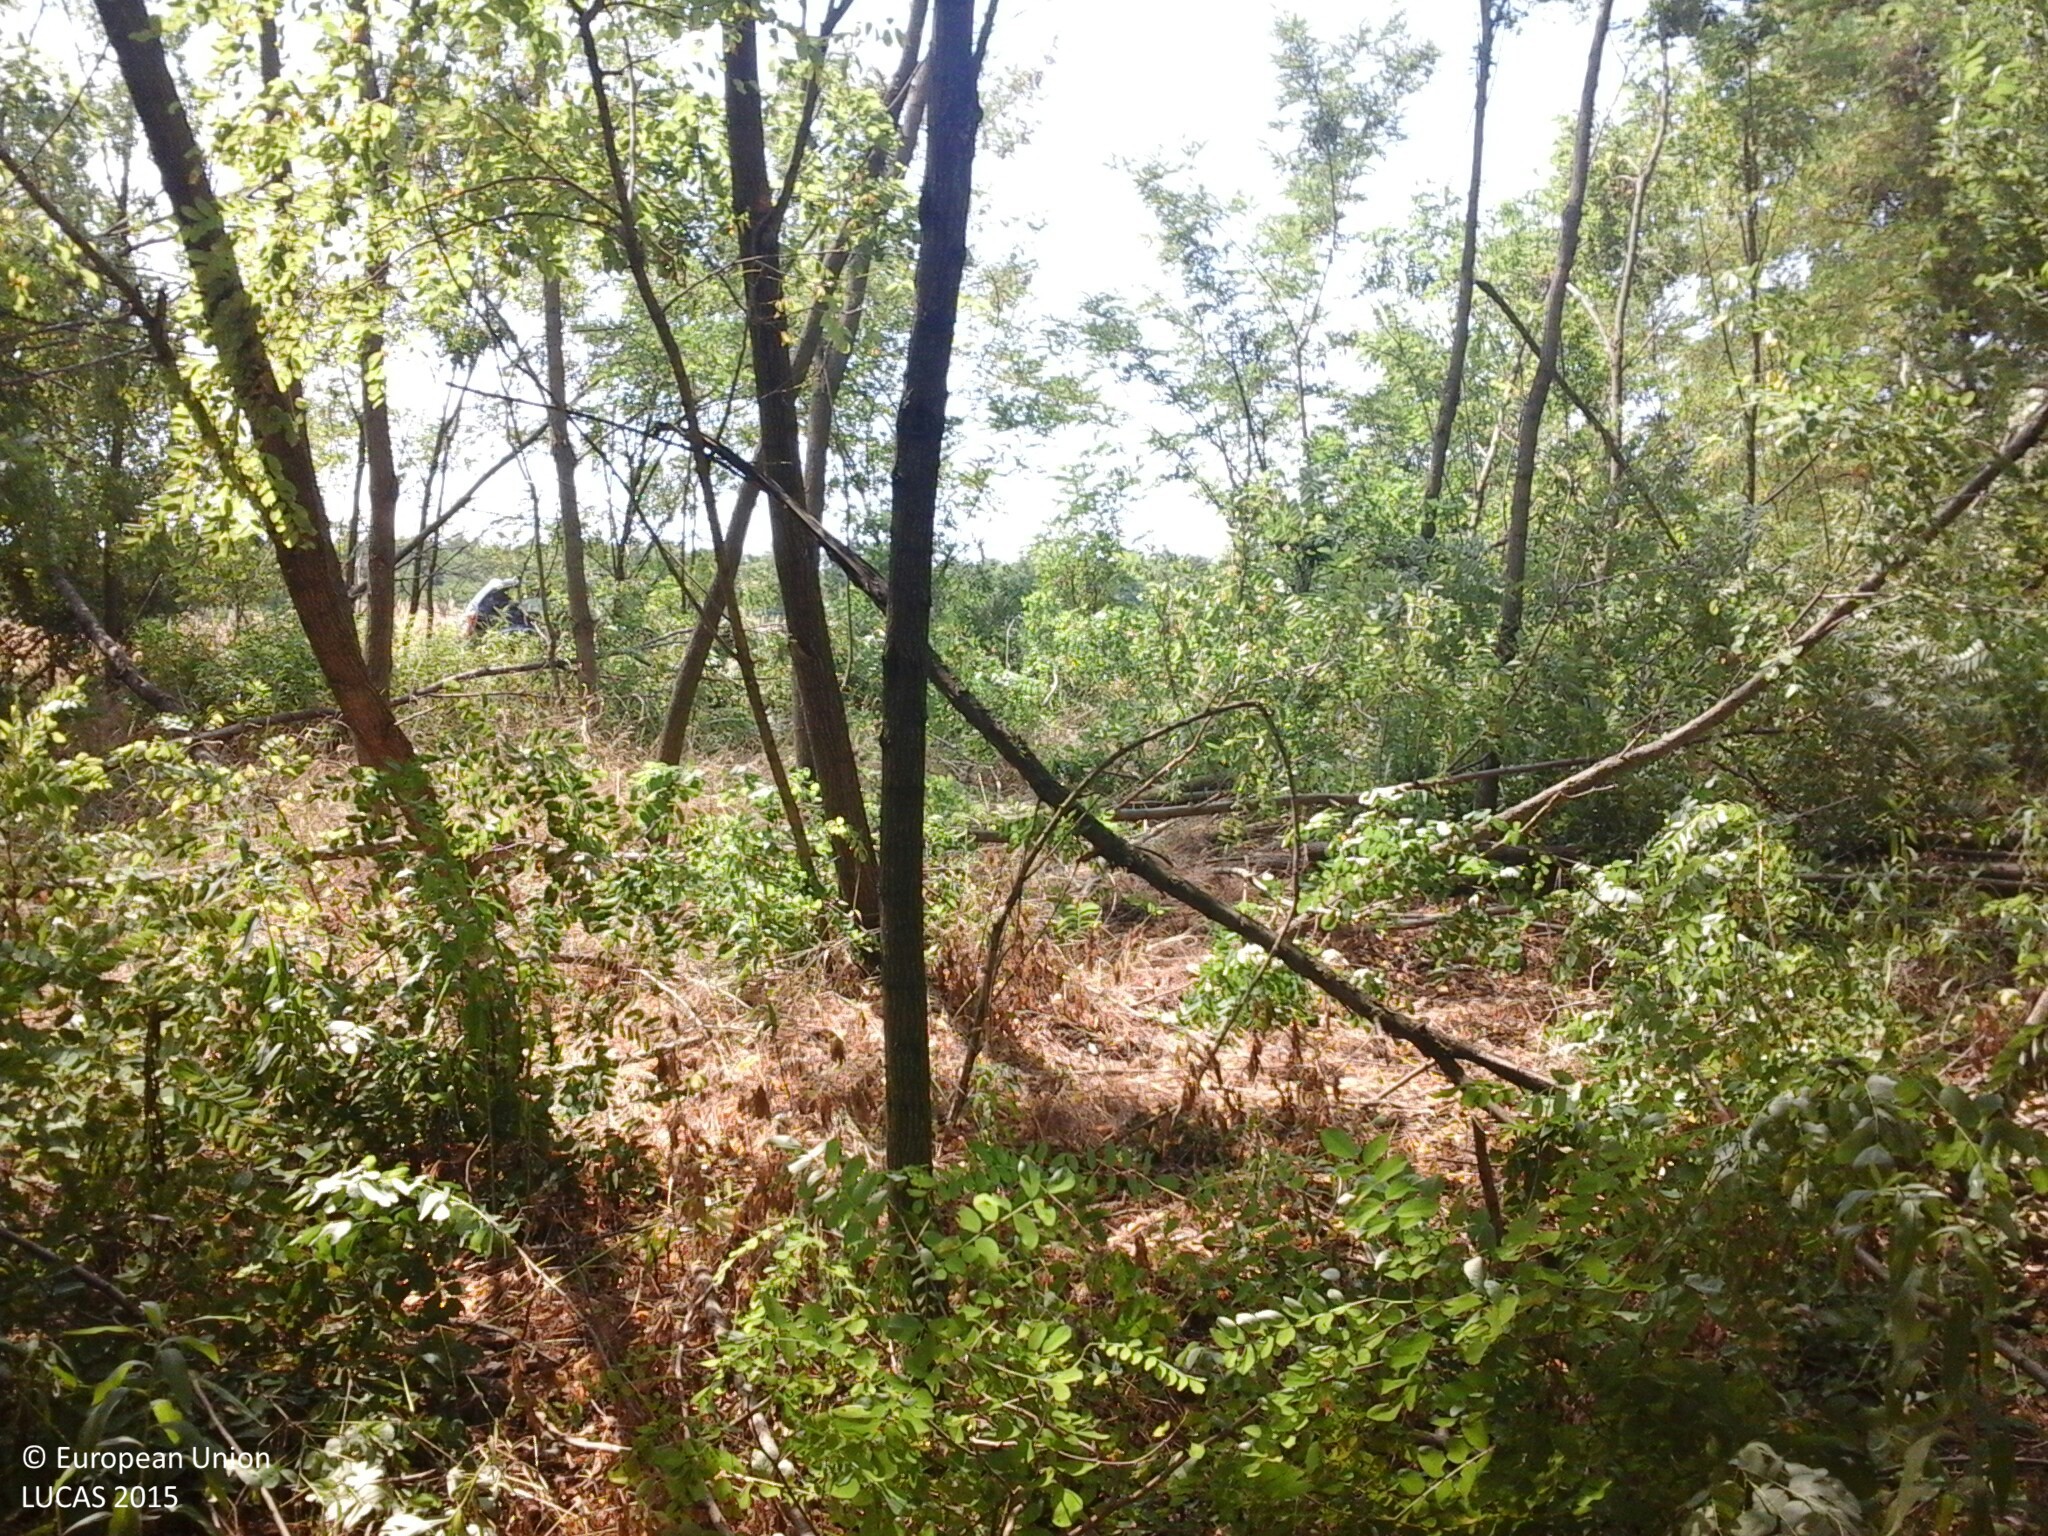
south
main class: Woodland
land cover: Broadleaved woodland
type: mesophytic deciduous forest
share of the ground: 50 - 75 %
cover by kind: broadleaved forest trees 95 %, herbaceous plants 5 %
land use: Forestry
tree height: > 5 m
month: July
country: HU
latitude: 48.3599
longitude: 22.2172
